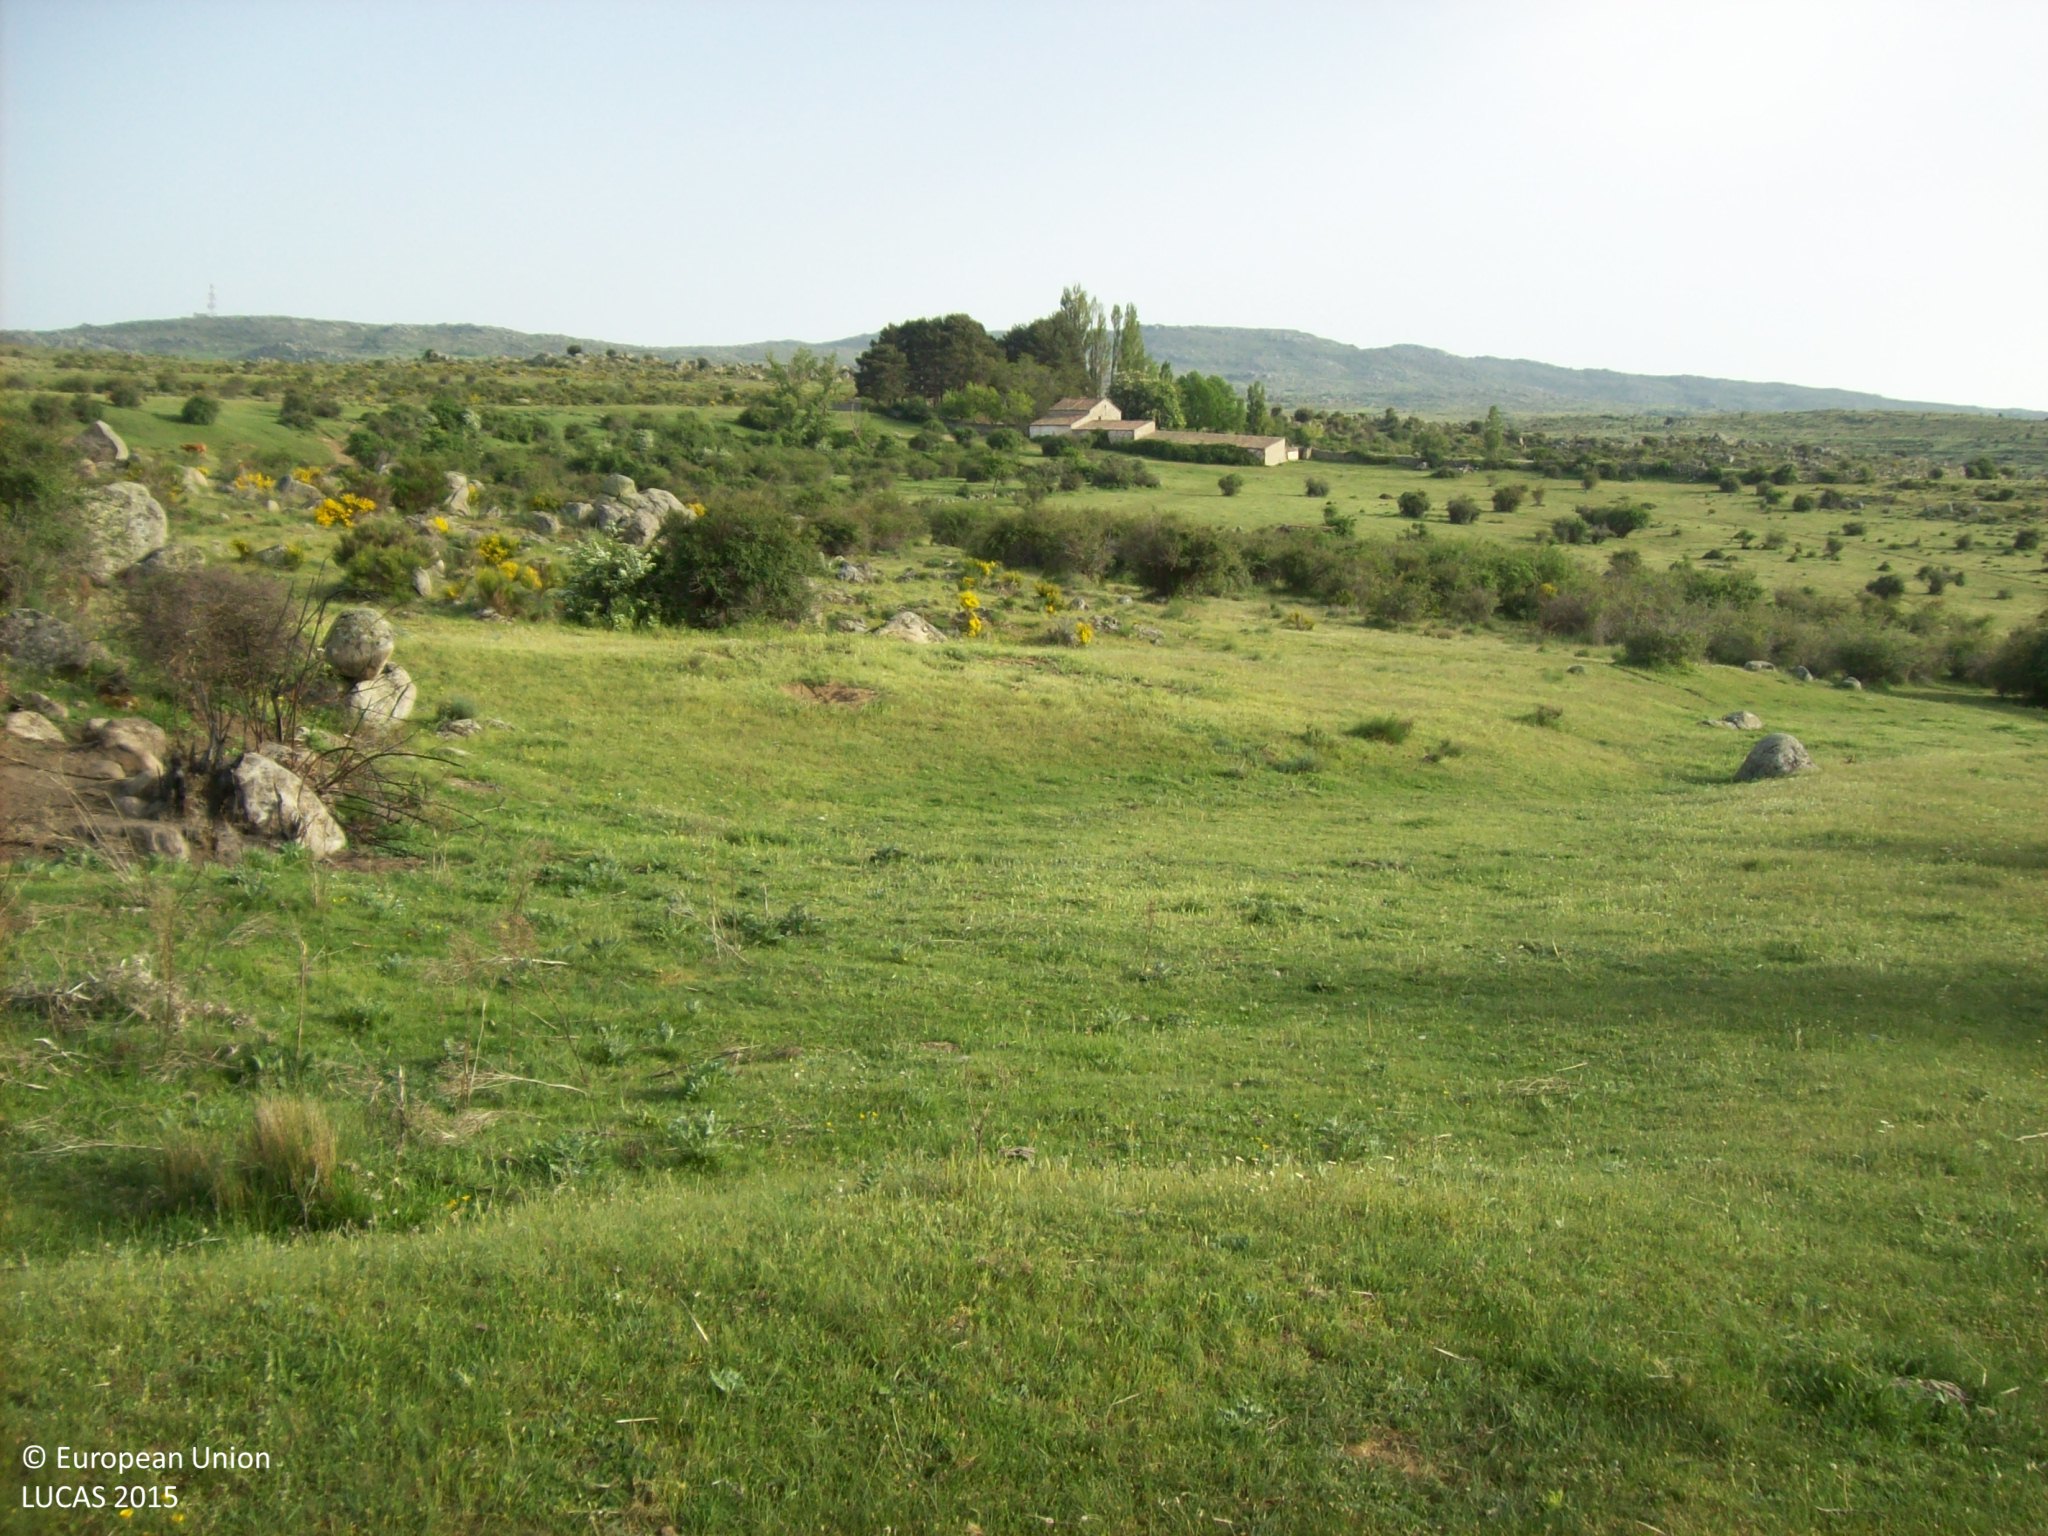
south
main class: Shrubland
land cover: Shrubland without tree cover
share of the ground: 10 - 25 %
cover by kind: herbaceous plants 75 %, shrubs 15 %, consolidated bare surface 10 %
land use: Agriculture (excluding fallow land and kitchen gardens)
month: May
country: ES
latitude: 40.7063
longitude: -4.8660
